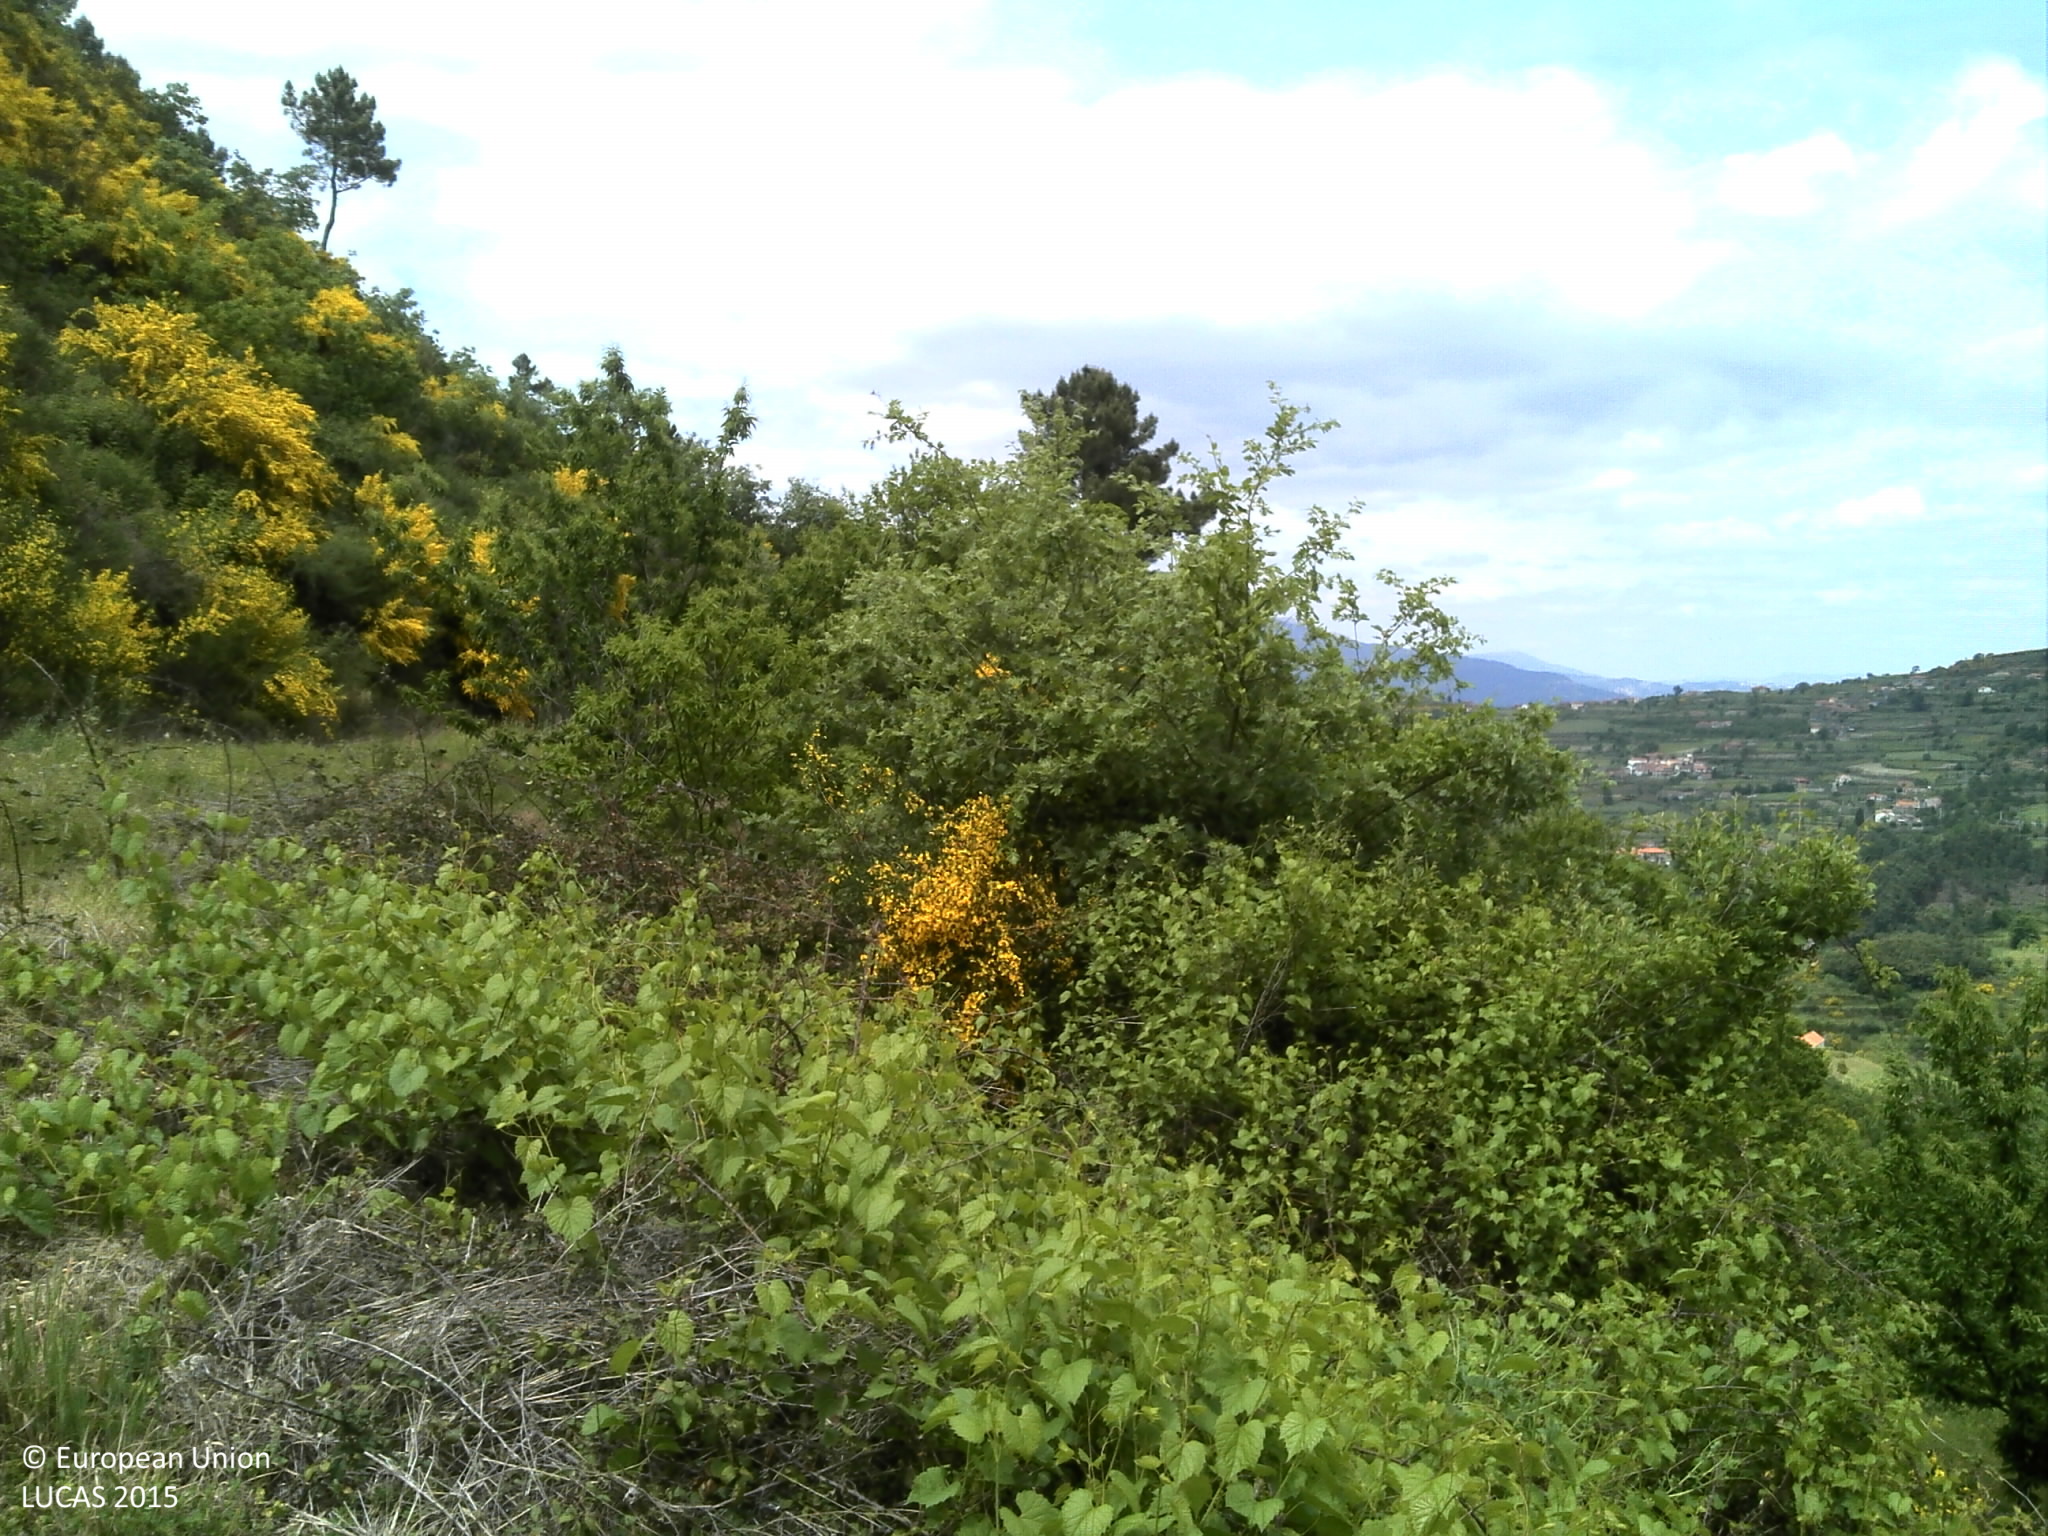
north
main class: Shrubland
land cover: Shrubland with sparse tree cover
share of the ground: 50 - 75 %
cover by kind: shrubs 75 %, herbaceous plants 15 %, broadleaved forest trees 5 %, unconsolidated bare surface 5 %
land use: Semi-natural and natural areas not in use
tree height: < 5 m
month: May
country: PT
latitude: 41.0720
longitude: -7.9488
